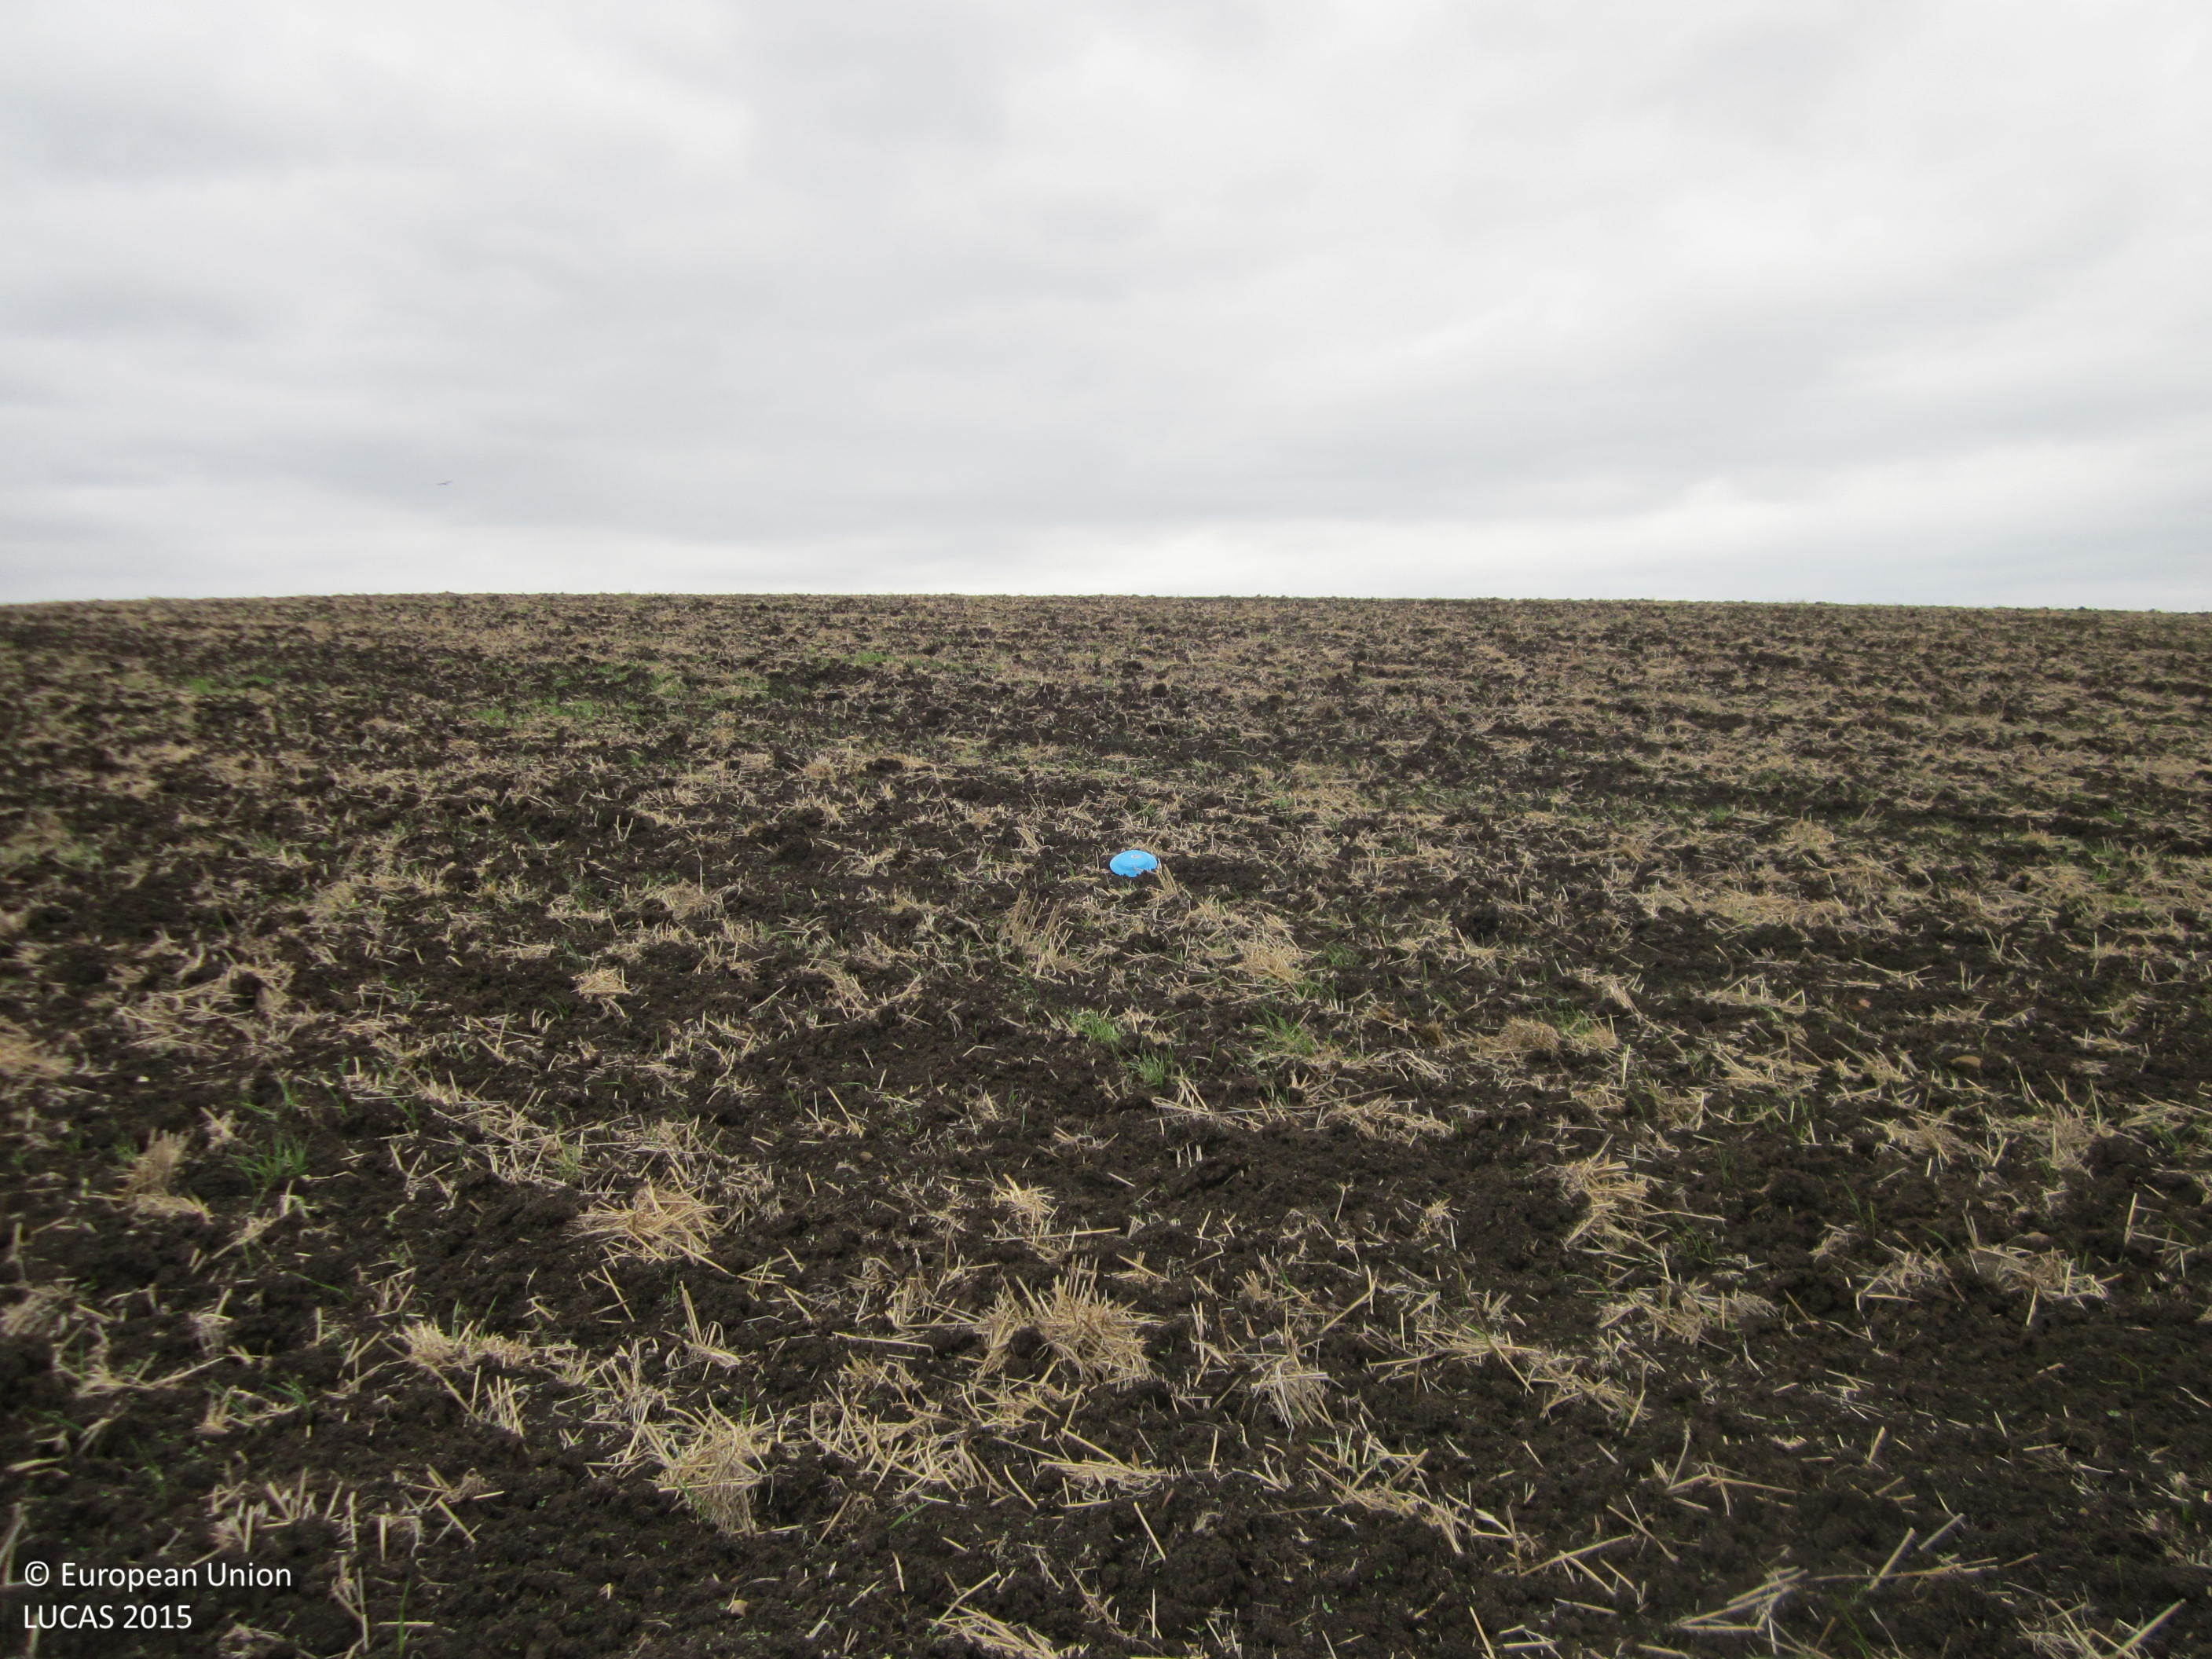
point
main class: Cropland
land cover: Common wheat
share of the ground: < 10 %
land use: Agriculture (excluding fallow land and kitchen gardens)
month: October
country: BG
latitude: 42.3739
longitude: 26.9455
